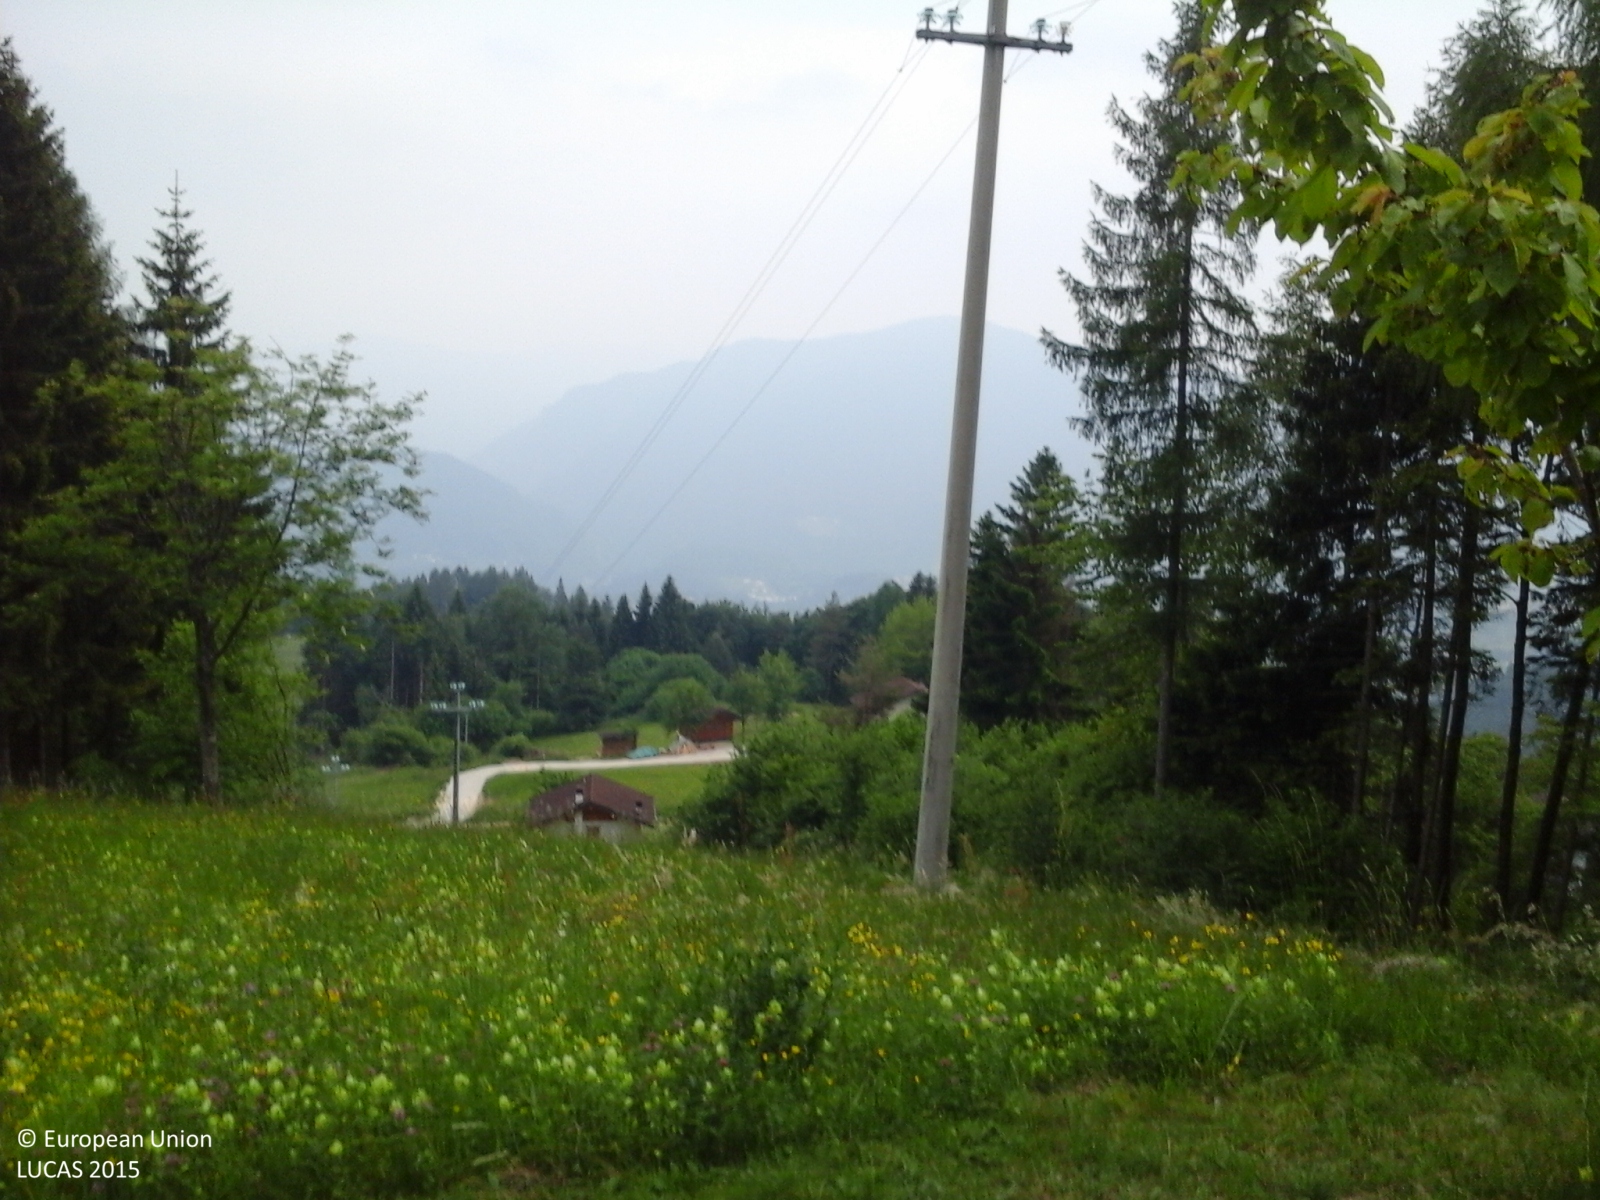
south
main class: Grassland
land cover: Grassland with sparse tree/shrub cover
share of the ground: > 75 %
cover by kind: herbaceous plants 80 %, broadleaved forest trees 5 %
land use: Residential
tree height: > 5 m
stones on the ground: < 10 %
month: May
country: IT
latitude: 46.0667
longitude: 11.7429
